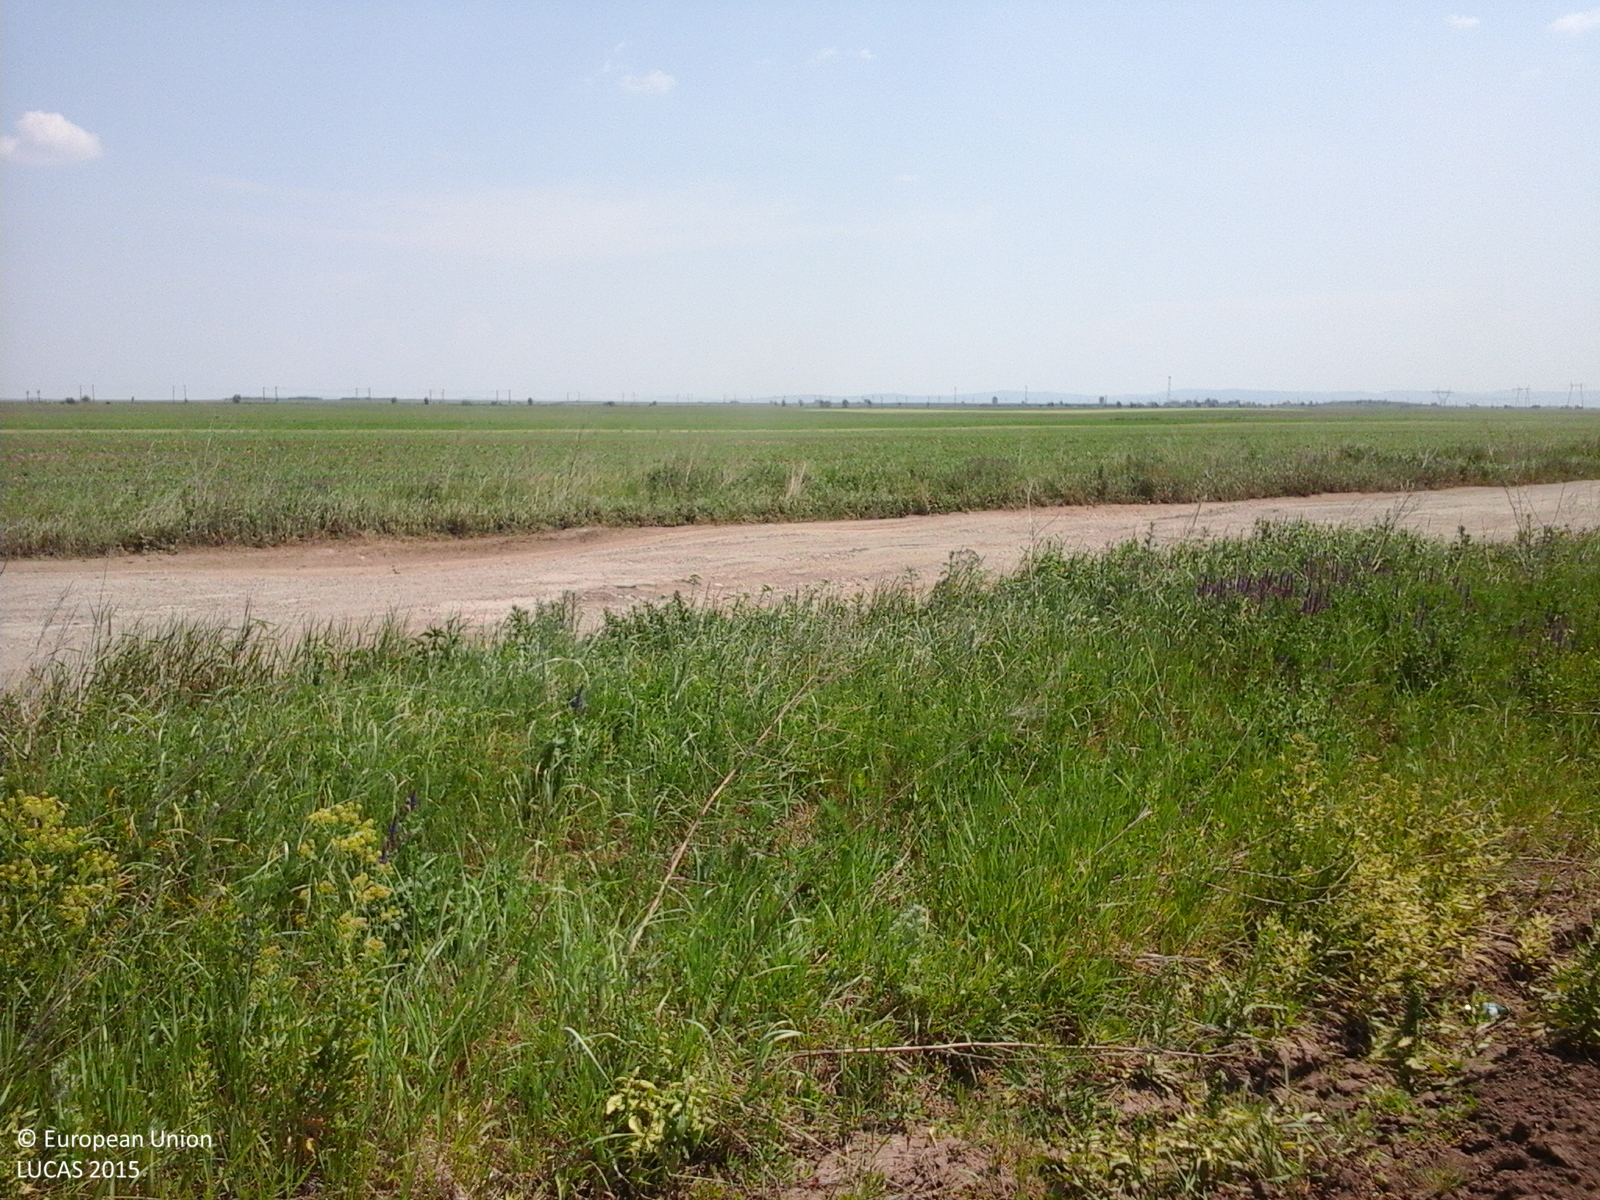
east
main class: Cropland
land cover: Maize
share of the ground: 25 - 50 %
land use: Agriculture (excluding fallow land and kitchen gardens)
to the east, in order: Maize; Grass margins; Paved roads, cycling and walking lanes; Ditches and canals; Grass margins; Maize; Sunflower; Maize; Lucerne; Sunflower; Maize; Lucerne
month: June
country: RO
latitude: 47.0426
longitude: 26.8503
